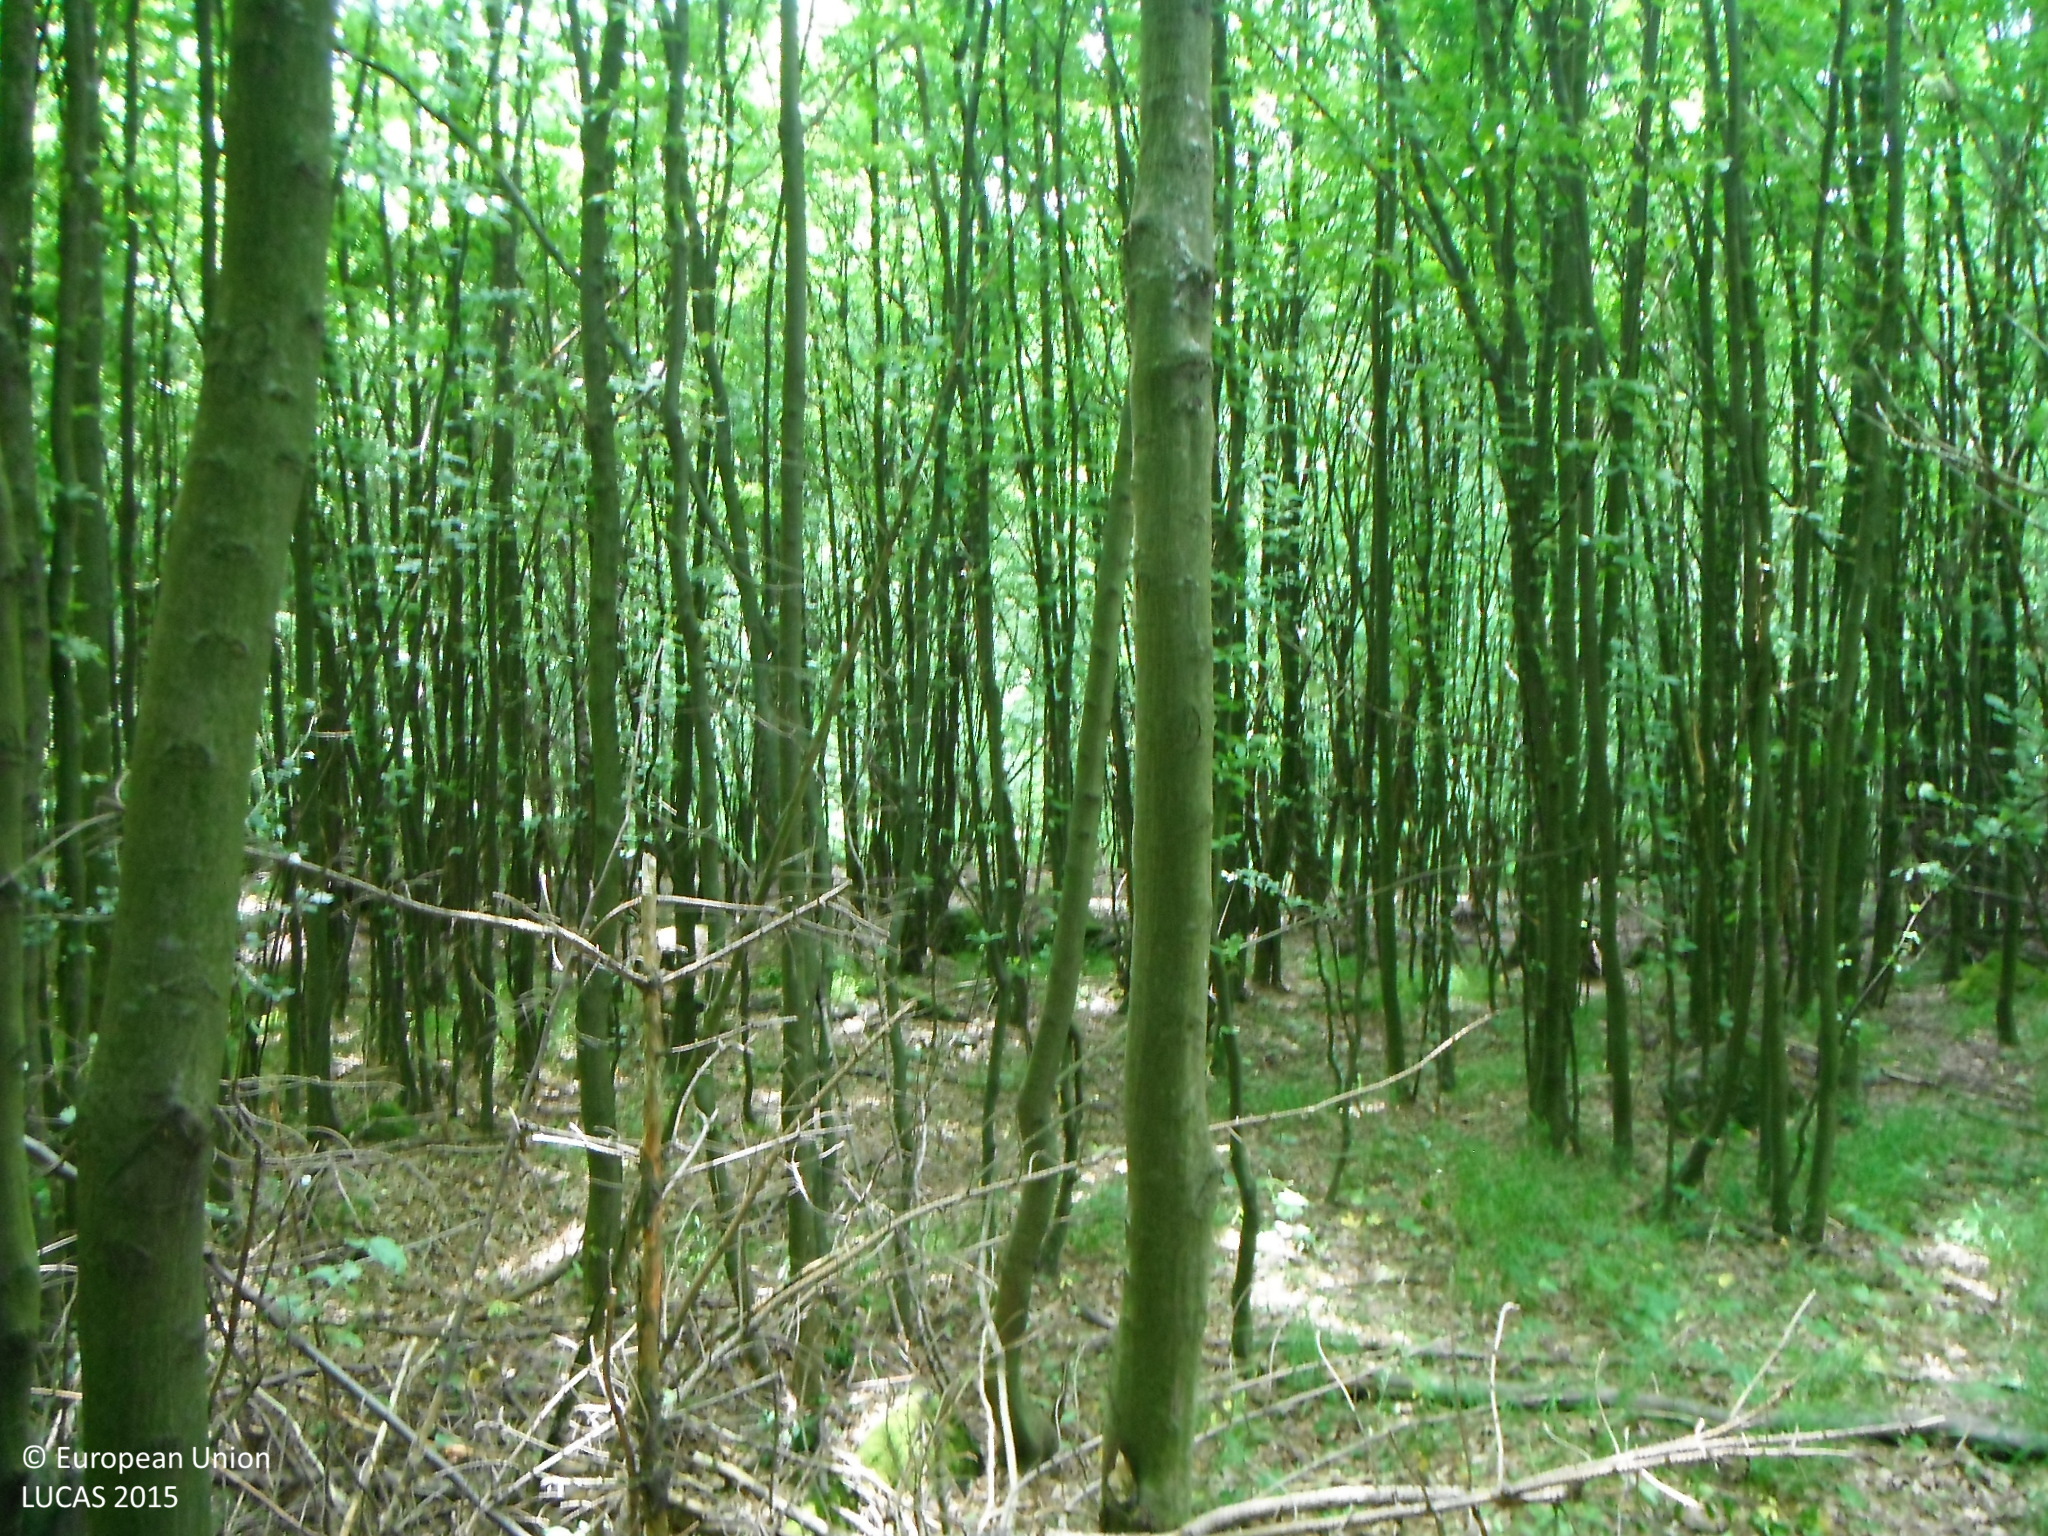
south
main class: Woodland
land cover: Broadleaved woodland
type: mesophytic deciduous forest
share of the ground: > 75 %
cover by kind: broadleaved forest trees 100 %
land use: Forestry
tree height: > 5 m
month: May
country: SK
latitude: 48.3864
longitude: 18.9185
